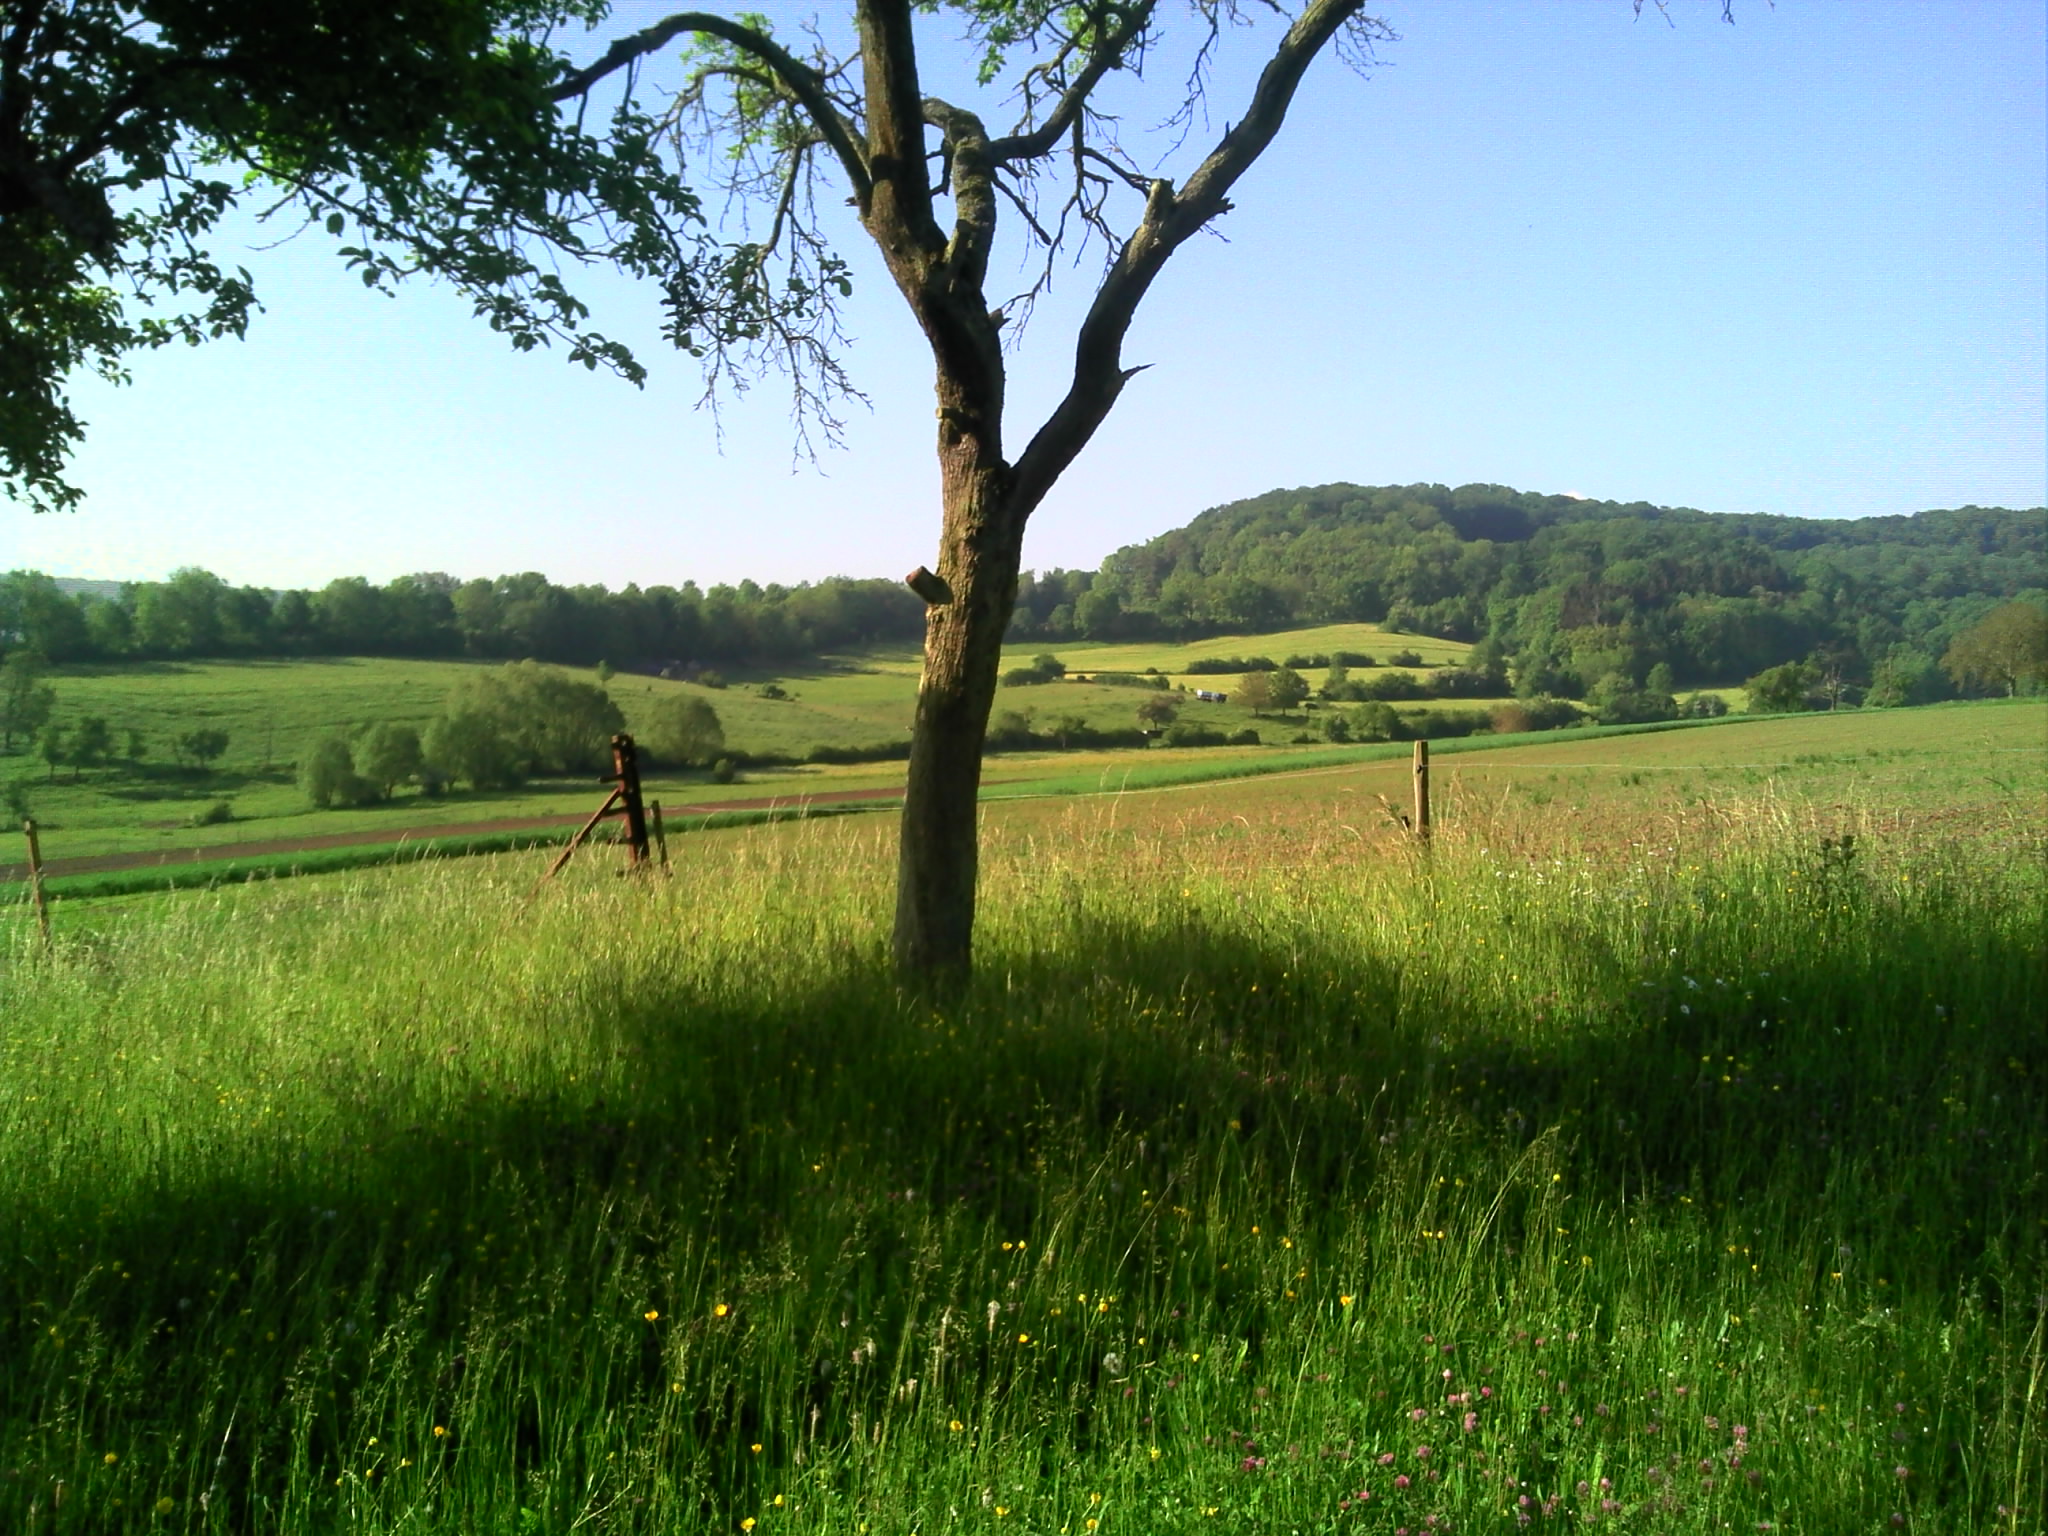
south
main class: Grassland
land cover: Grassland with sparse tree/shrub cover
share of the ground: > 75 %
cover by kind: herbaceous plants 95 %, broadleaved forest trees 5 %
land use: Agriculture (excluding fallow land and kitchen gardens)
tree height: > 5 m
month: May
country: LU
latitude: 49.5485
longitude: 6.3093
